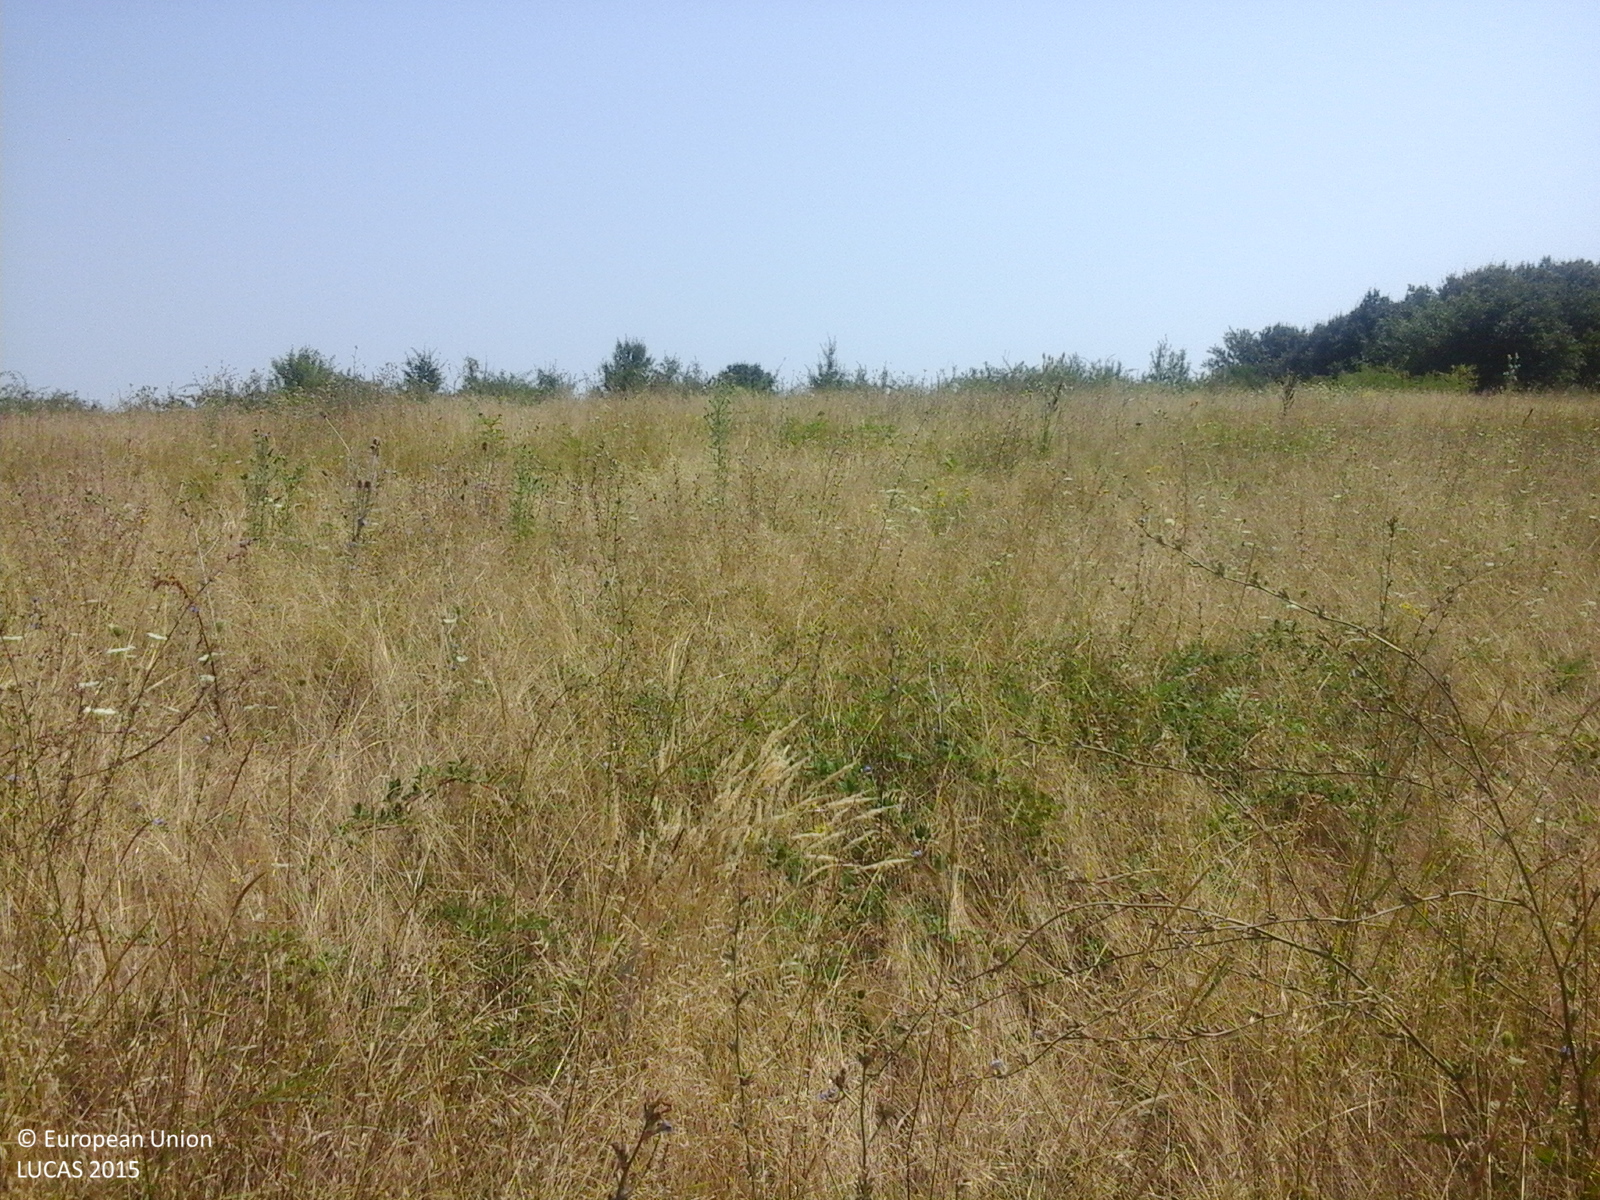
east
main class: Grassland
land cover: Grassland without tree/shrub cover
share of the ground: > 75 %
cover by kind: herbaceous plants 100 %
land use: Agriculture (excluding fallow land and kitchen gardens)
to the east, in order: Grassland without tree/shrub cover; Shrubland with sparse tree cover; Tracks; Broadleaved woodland
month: August
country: RO
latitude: 44.5738
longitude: 23.1065
